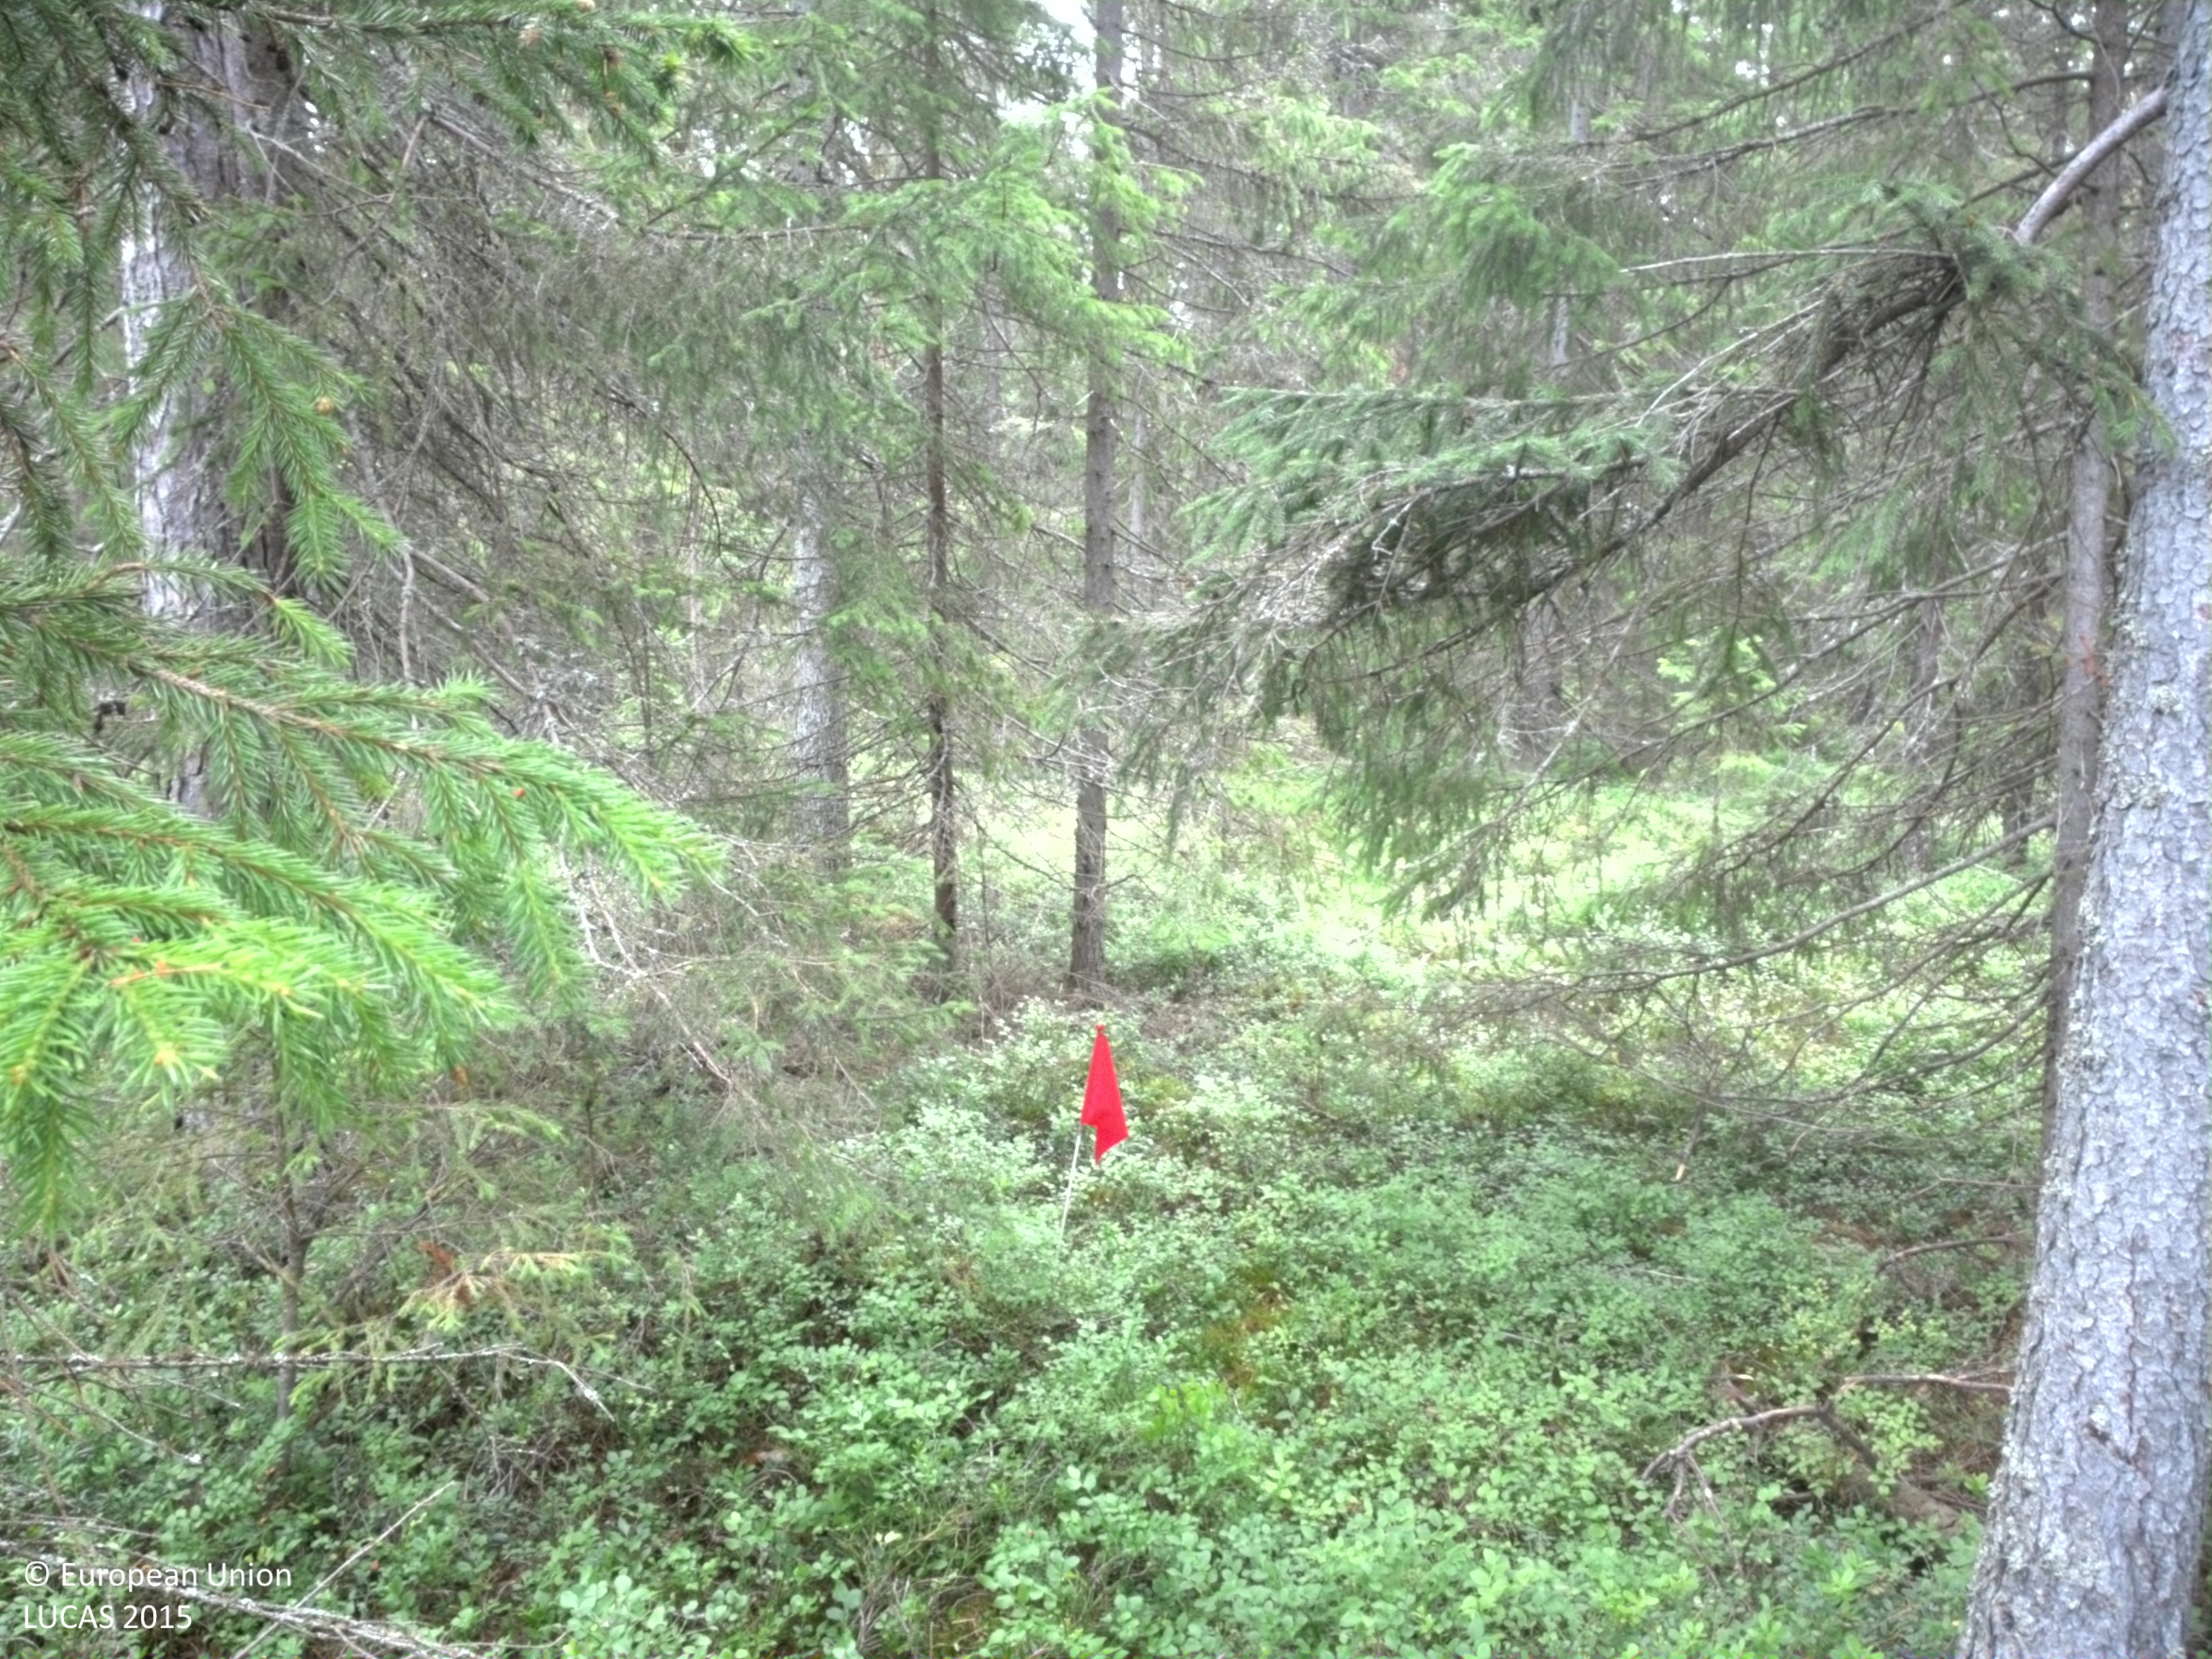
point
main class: Woodland
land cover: Spruce dominated coniferous woodland
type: boreal forest
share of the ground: 50 - 75 %
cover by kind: coniferous forest trees 75 %, shrubs 25 %
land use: Forestry
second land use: Amenities, museums, leisure
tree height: > 5 m
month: July
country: SE
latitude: 64.5949
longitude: 21.3265
